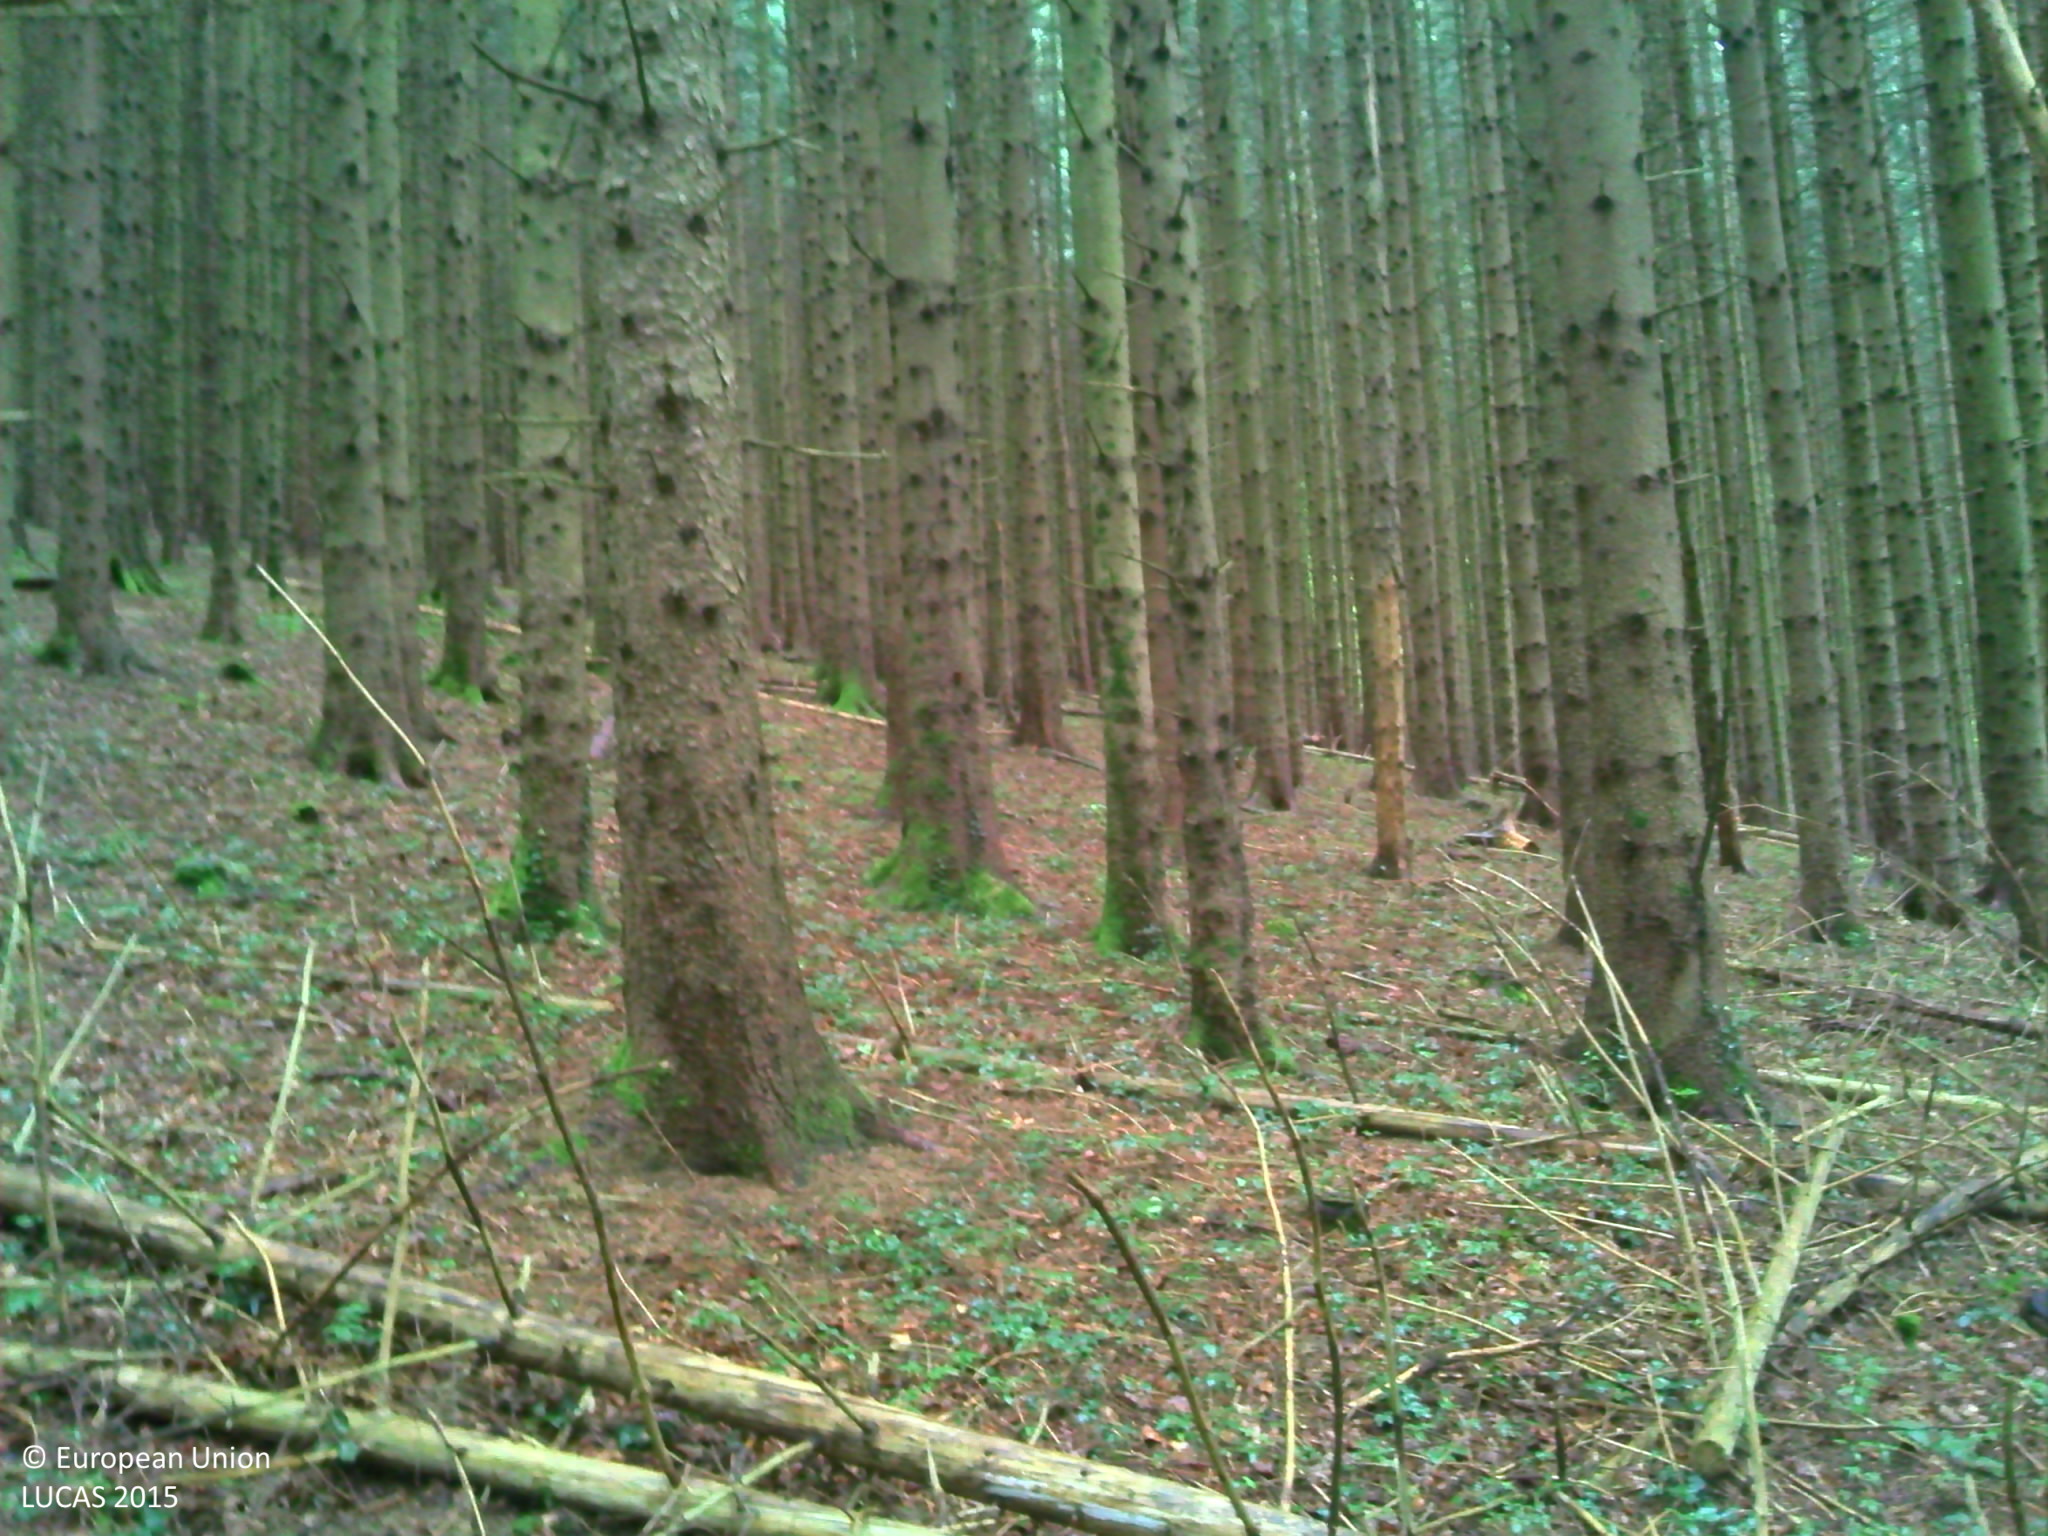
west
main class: Woodland
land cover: Spruce dominated coniferous woodland
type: alpine coniferous forest
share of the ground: > 75 %
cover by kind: coniferous forest trees 70 %, broadleaved forest trees 15 %, herbaceous plants 10 %, lichens and mosses 5 %
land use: Forestry
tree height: > 5 m
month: July
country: FR
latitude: 45.9798
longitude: 6.2735
